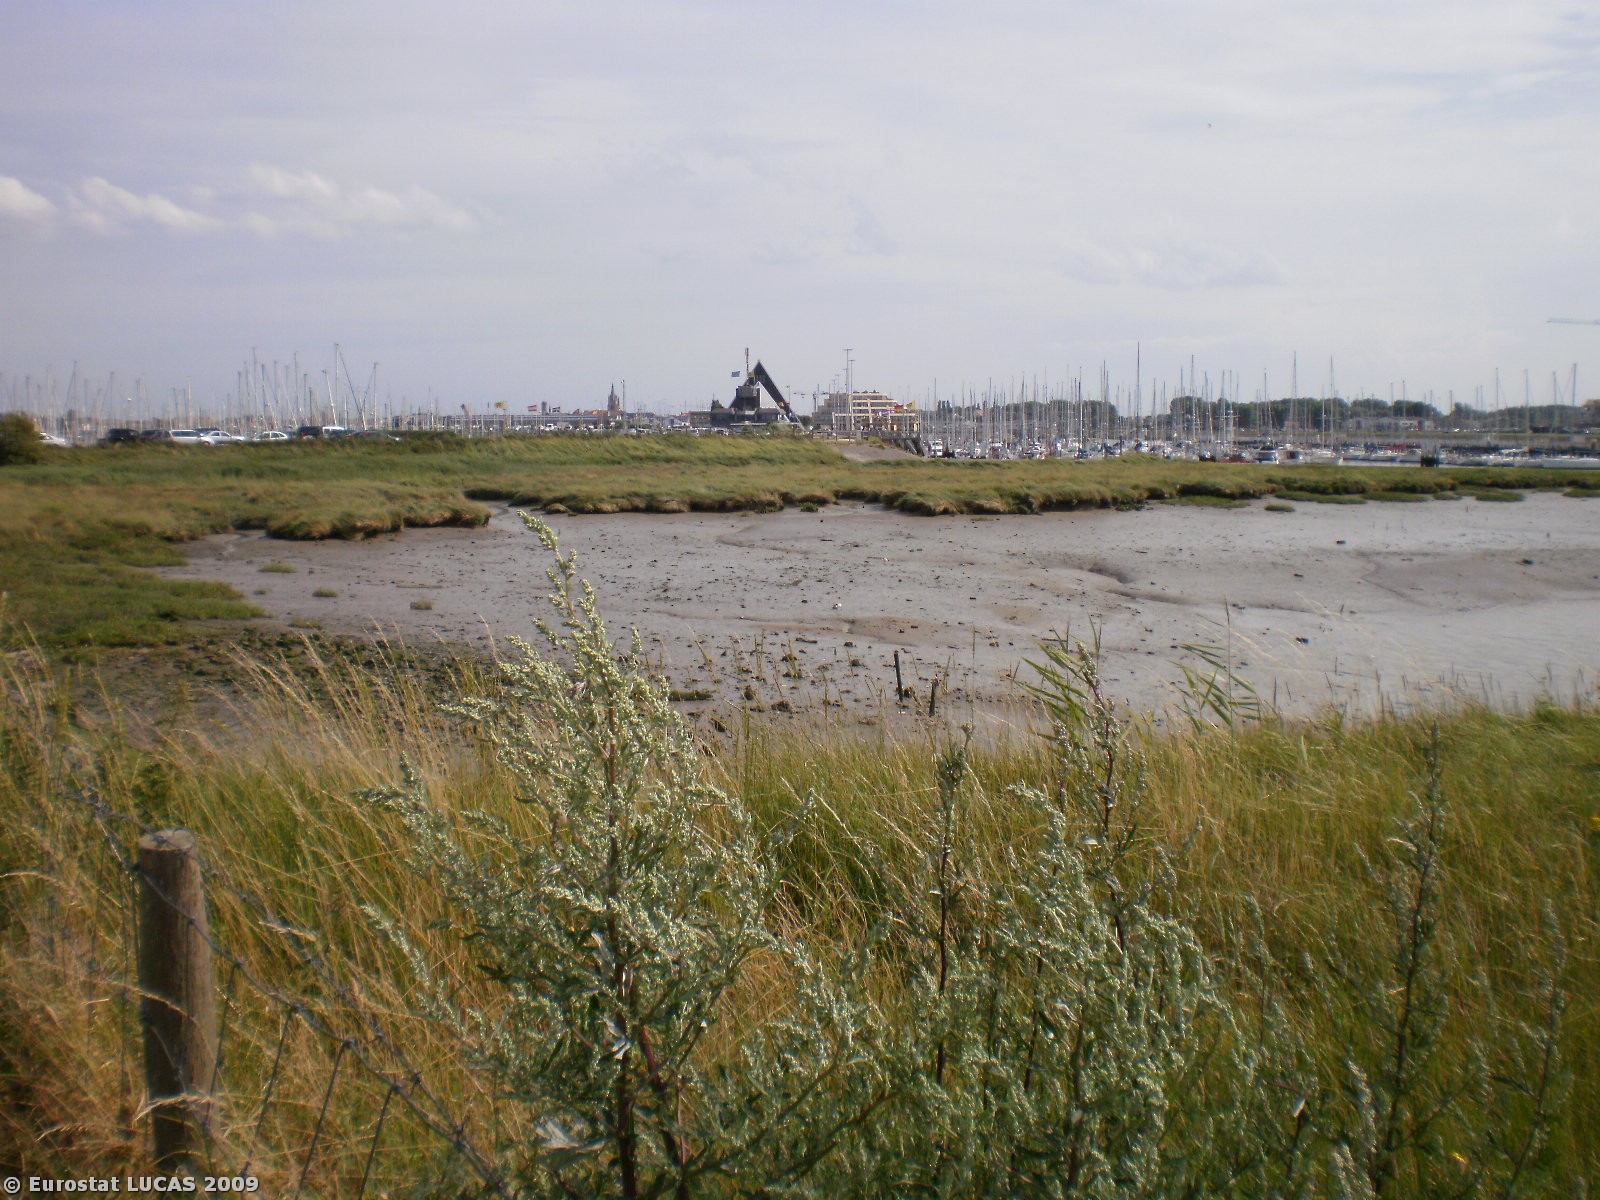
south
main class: Wetlands
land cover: Intertidal flats
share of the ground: > 75 %
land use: Nature reserves
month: July
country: BE
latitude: 51.1443
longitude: 2.7414
